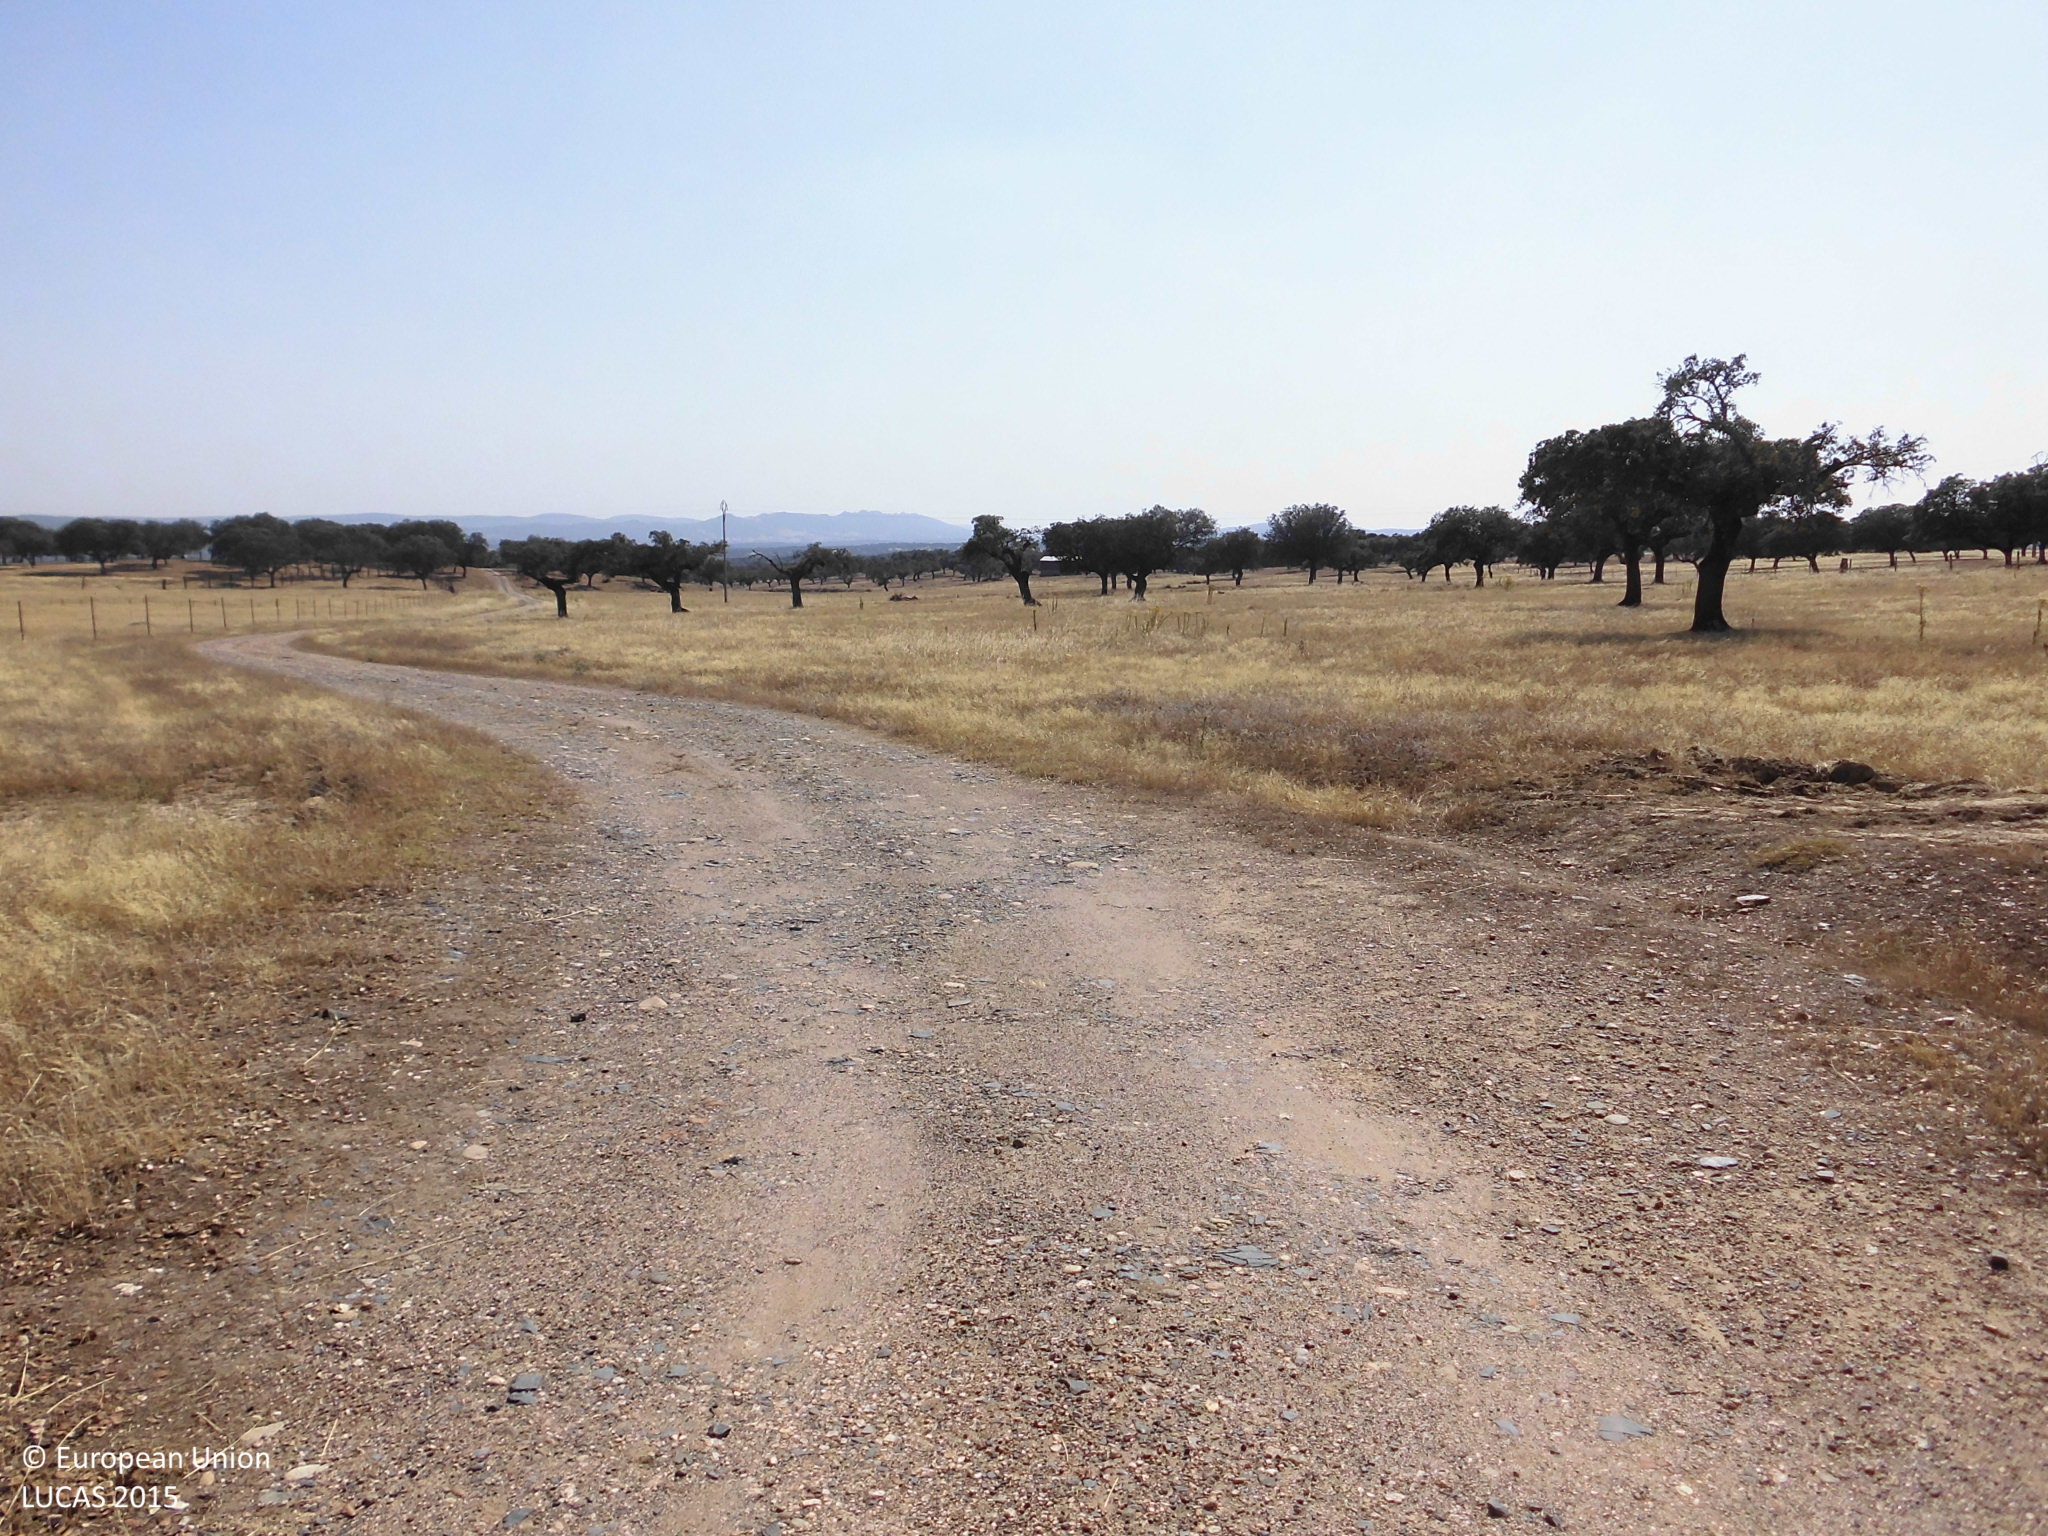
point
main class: Grassland
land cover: Grassland without tree/shrub cover
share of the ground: > 75 %
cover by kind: herbaceous plants 100 %
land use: Agriculture (excluding fallow land and kitchen gardens)
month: June
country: ES
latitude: 39.9238
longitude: -6.0874
